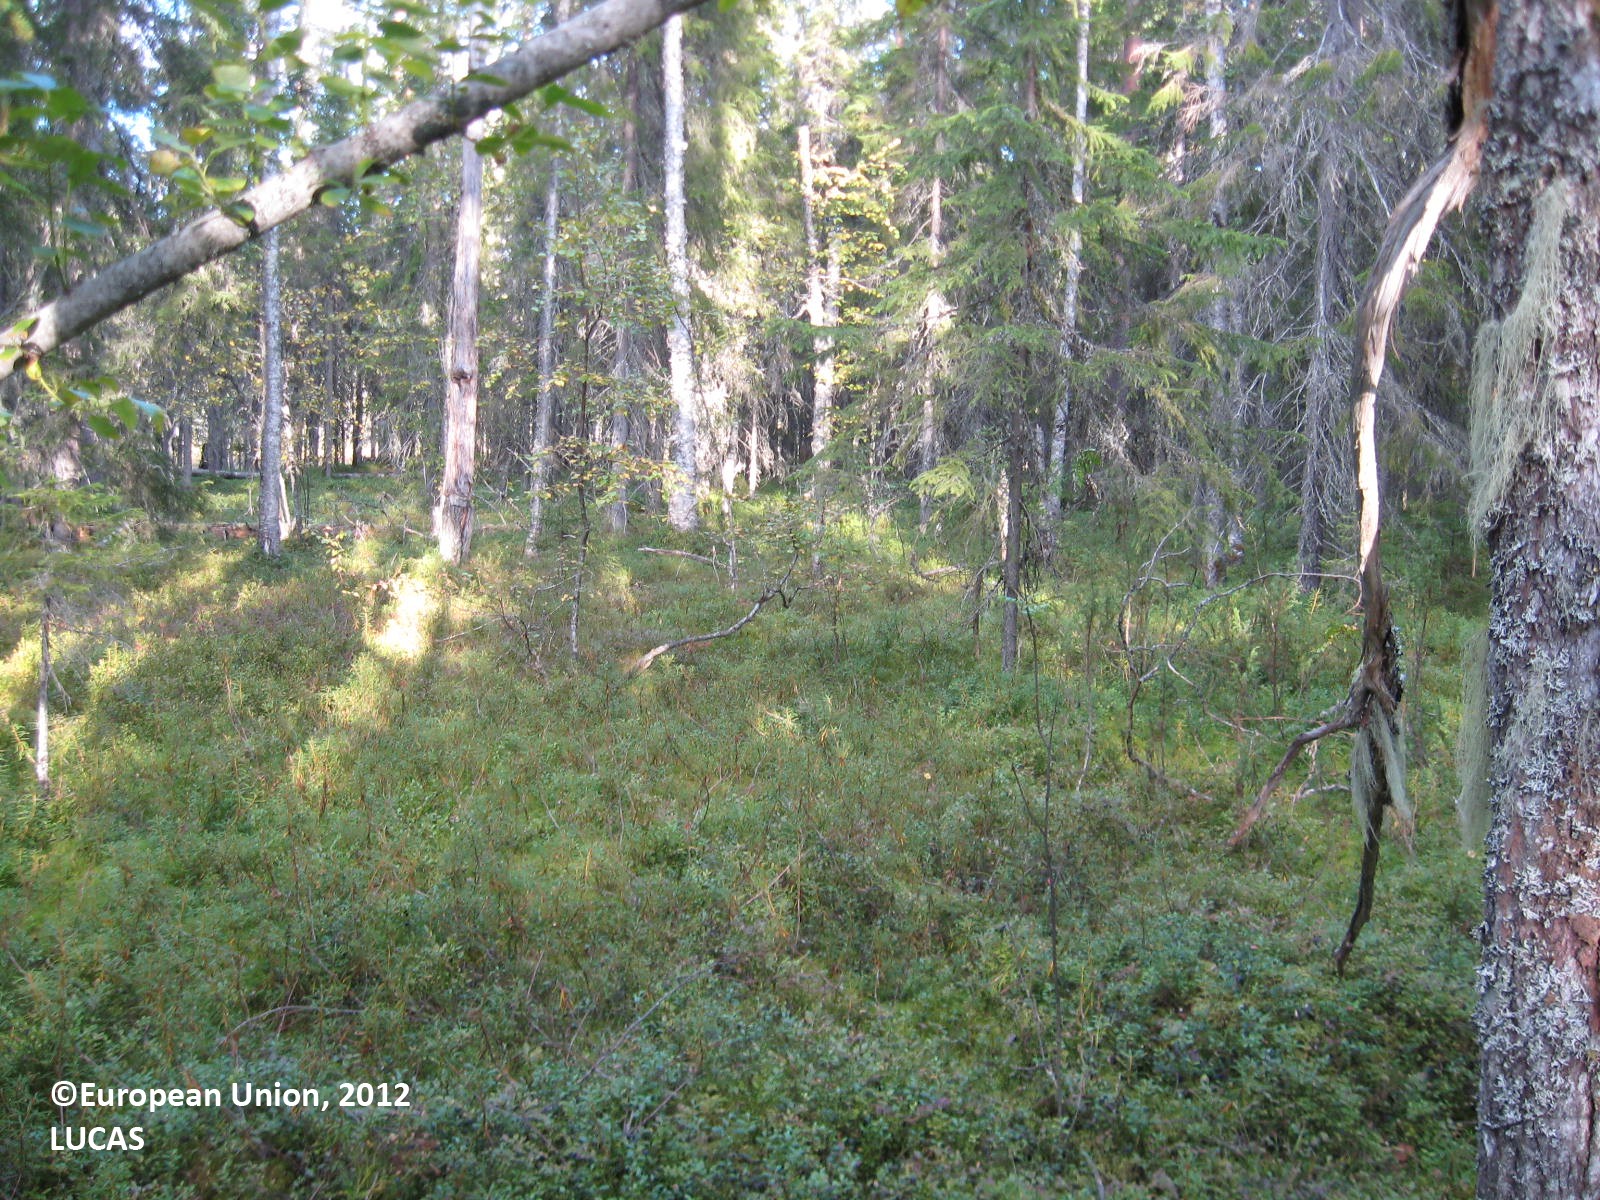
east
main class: Woodland
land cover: Spruce dominated coniferous woodland
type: boreal forest
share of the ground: > 75 %
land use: Forestry
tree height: > 5 m
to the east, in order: Spruce dominated coniferous woodland; Peatbogs
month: August
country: FI
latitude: 63.9083
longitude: 29.8616
